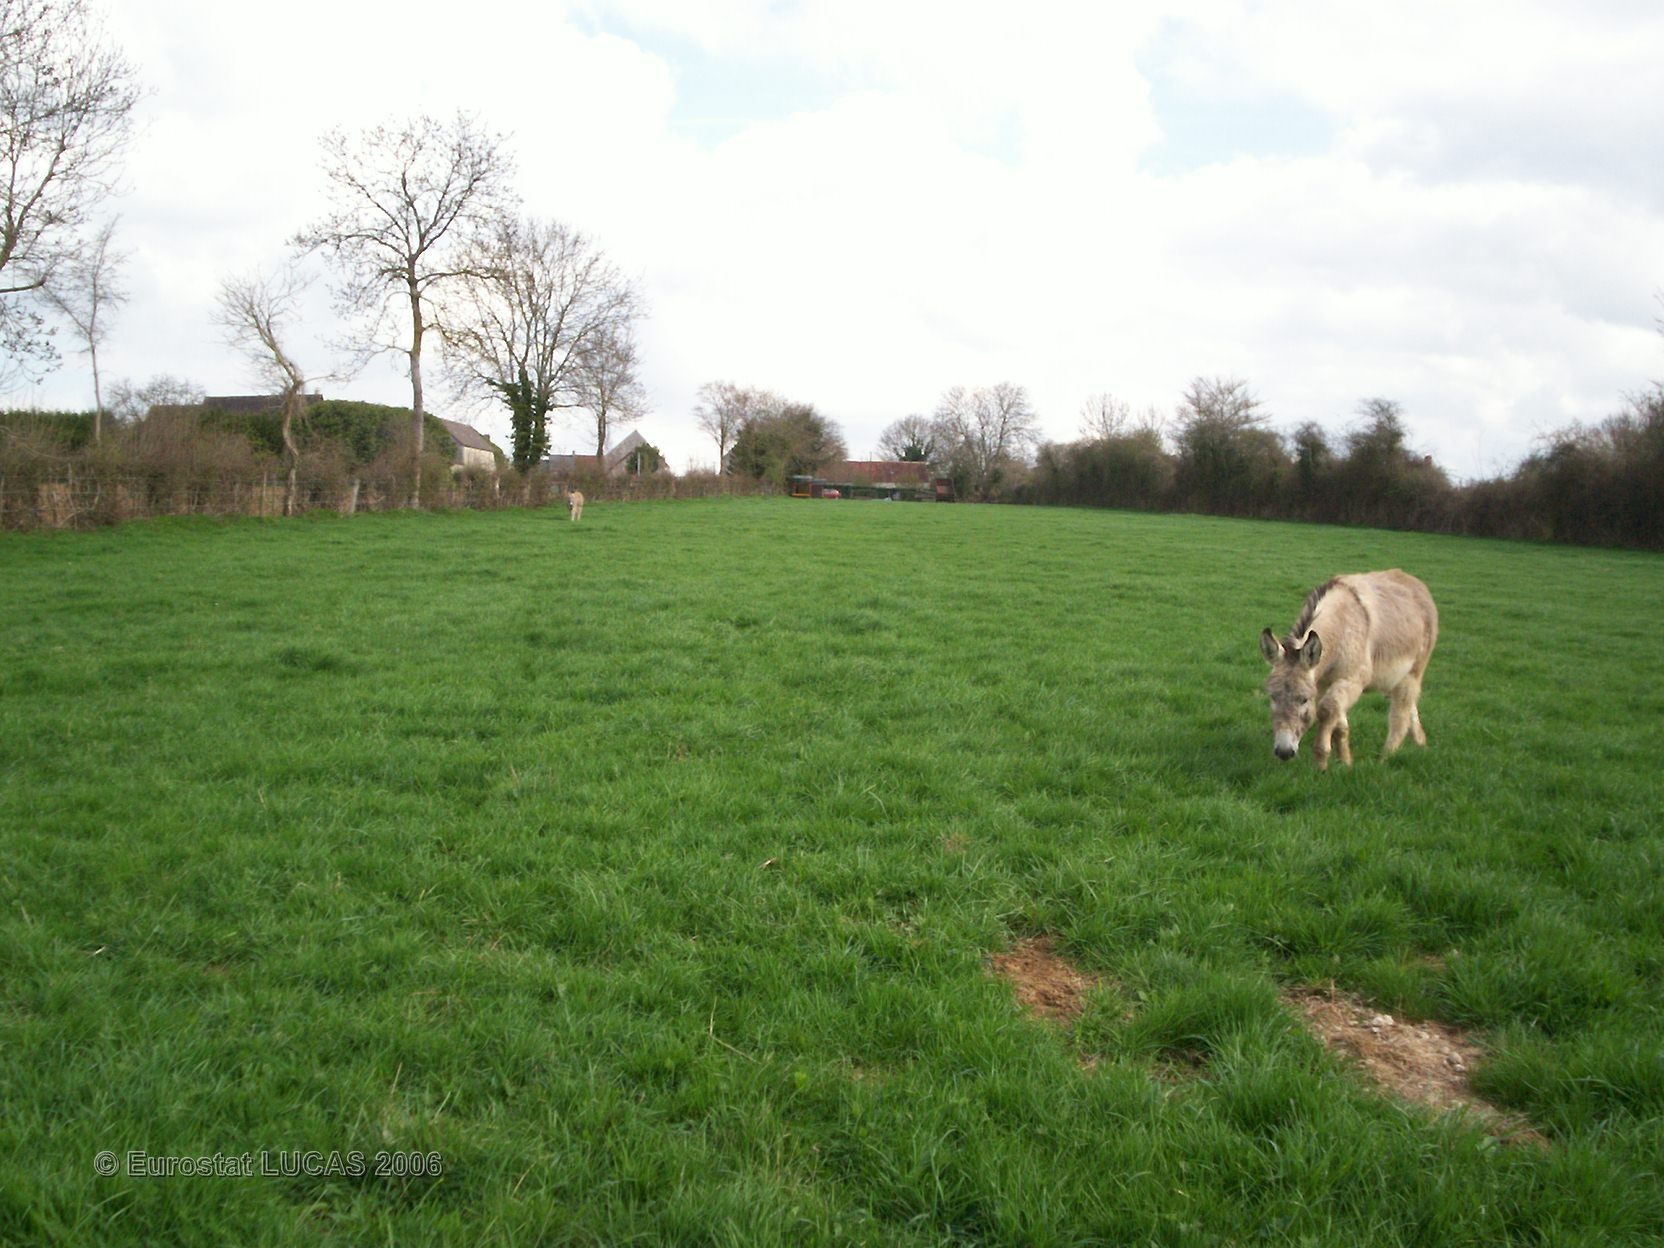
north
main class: Grassland
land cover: Grassland without tree/shrub cover
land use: Agriculture (excluding fallow land and kitchen gardens)
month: April
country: FR
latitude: 48.8082
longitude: -0.1214
